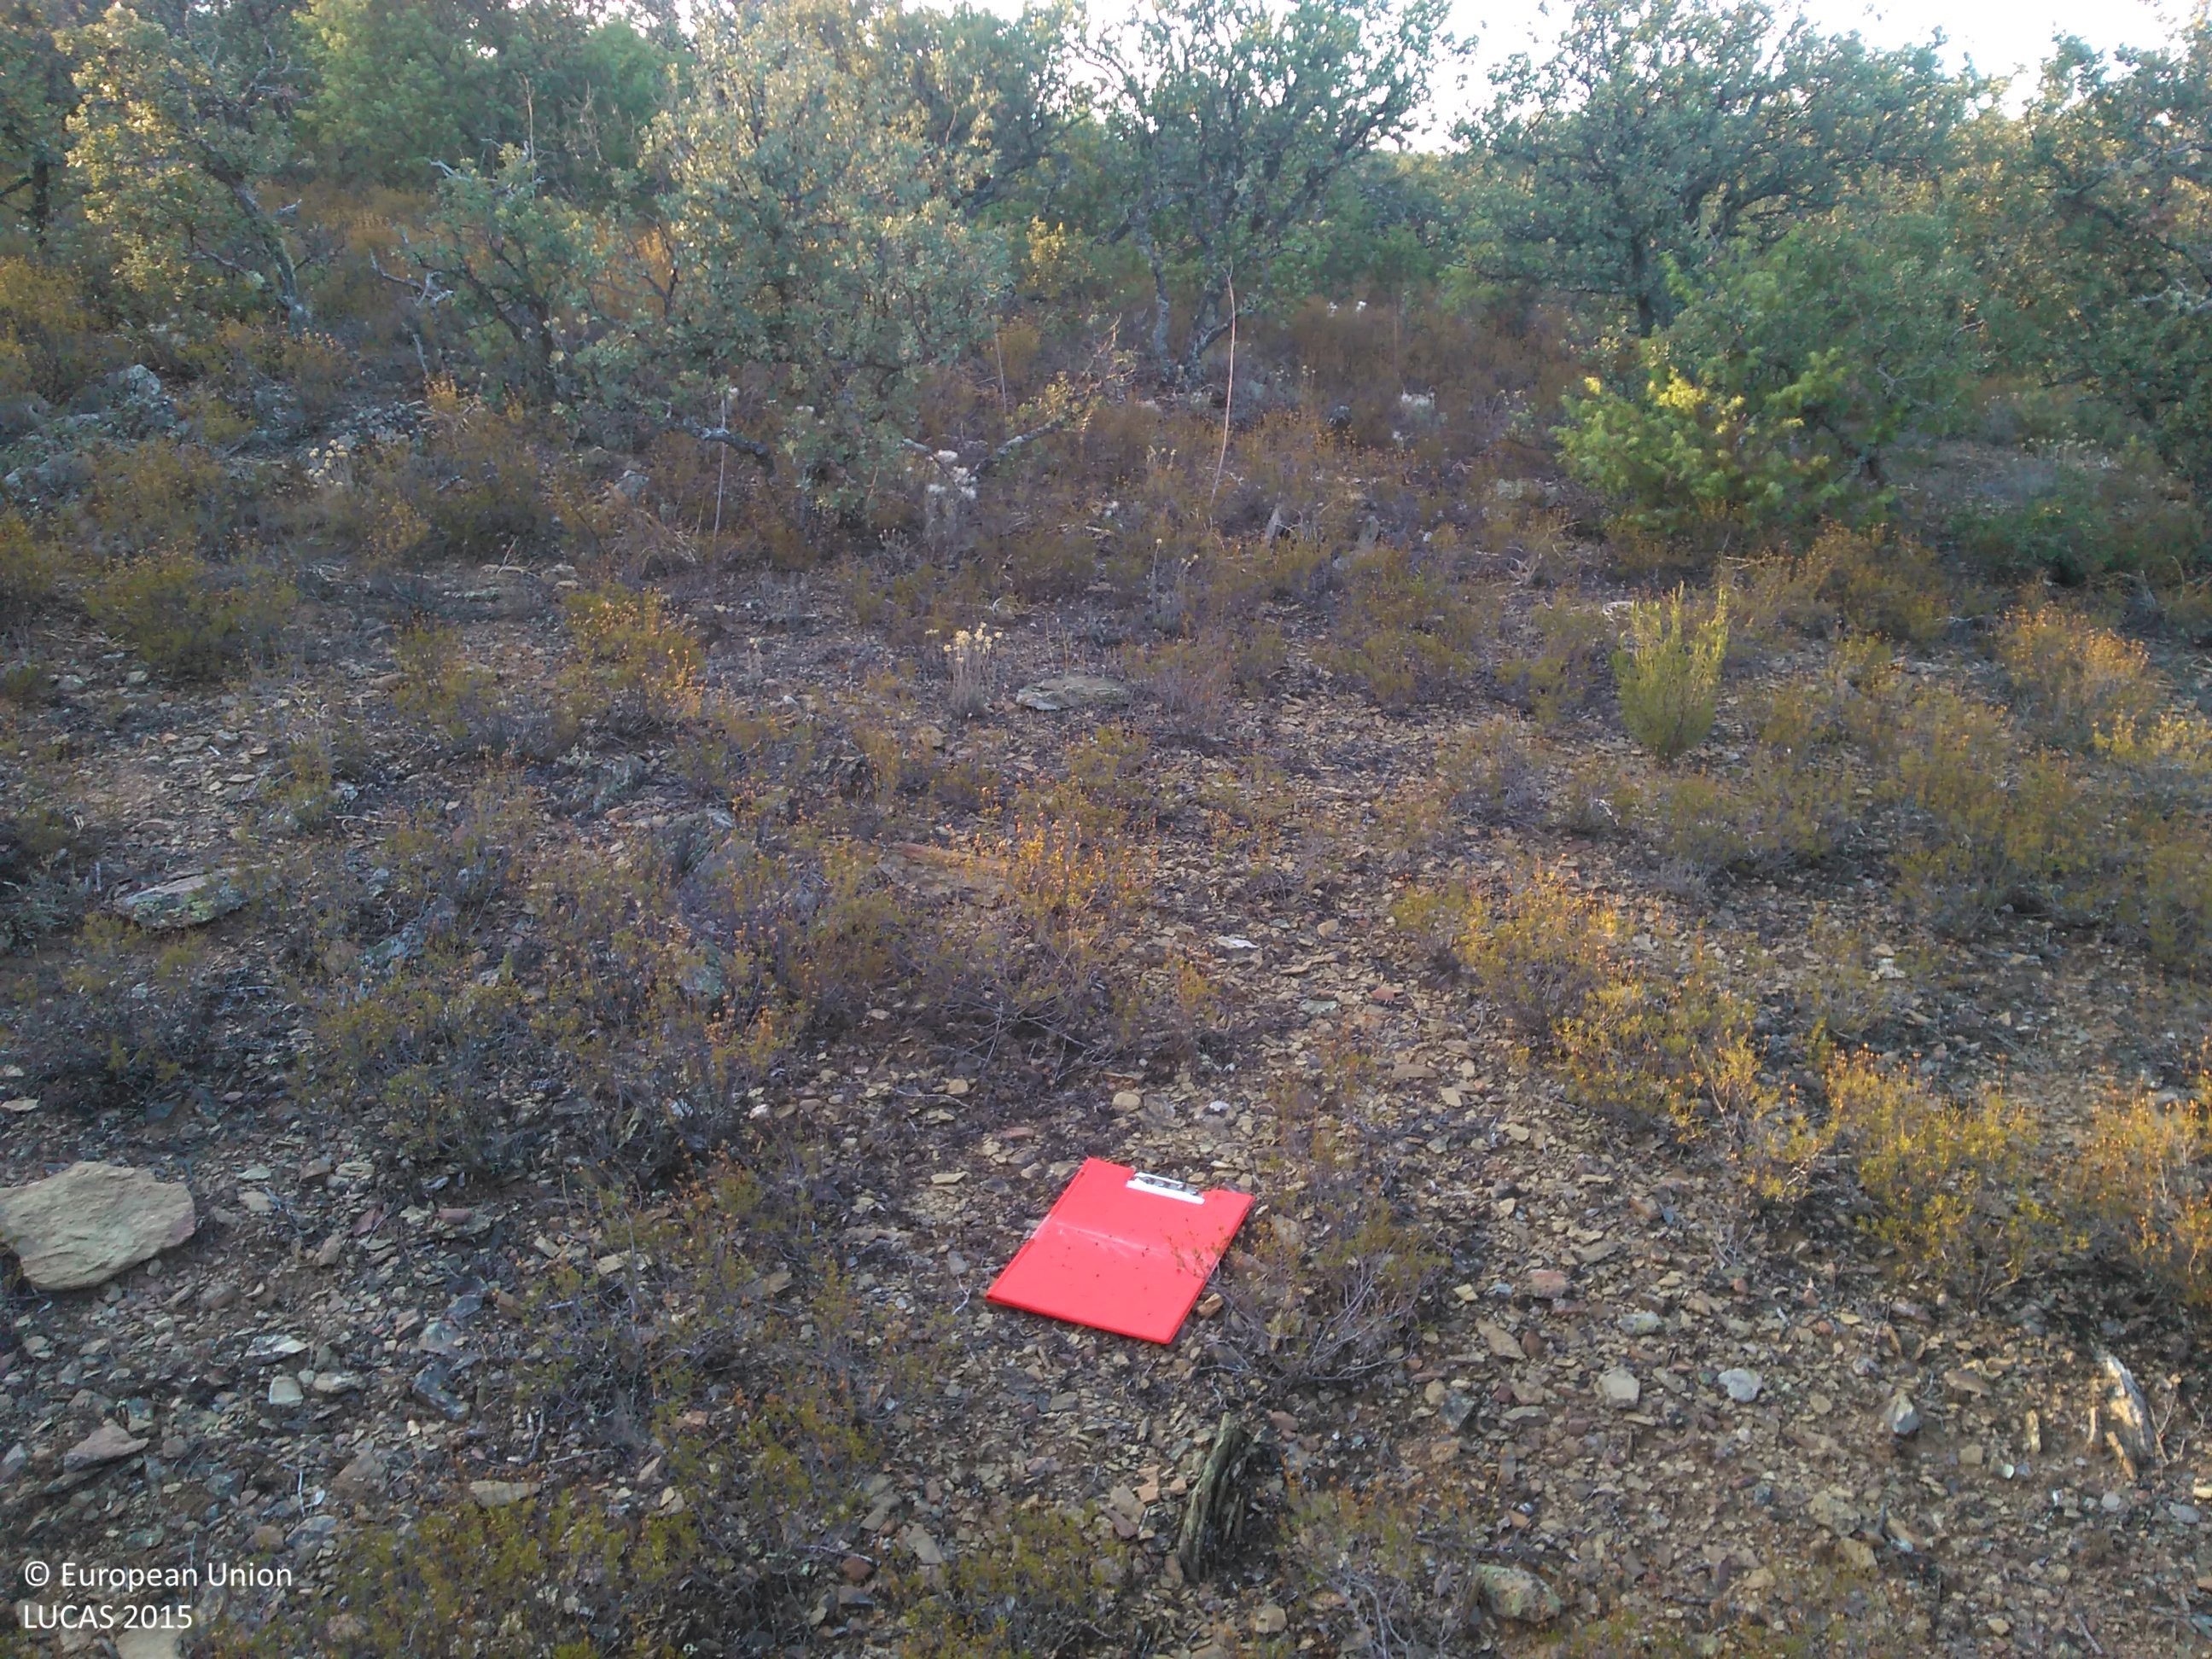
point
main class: Woodland
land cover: Broadleaved woodland
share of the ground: 50 - 75 %
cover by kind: broadleaved forest trees 50 %, shrubs 30 %, unconsolidated bare surface 20 %
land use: Semi-natural and natural areas not in use
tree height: < 5 m
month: July
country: ES
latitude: 41.4226
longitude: -1.8858
